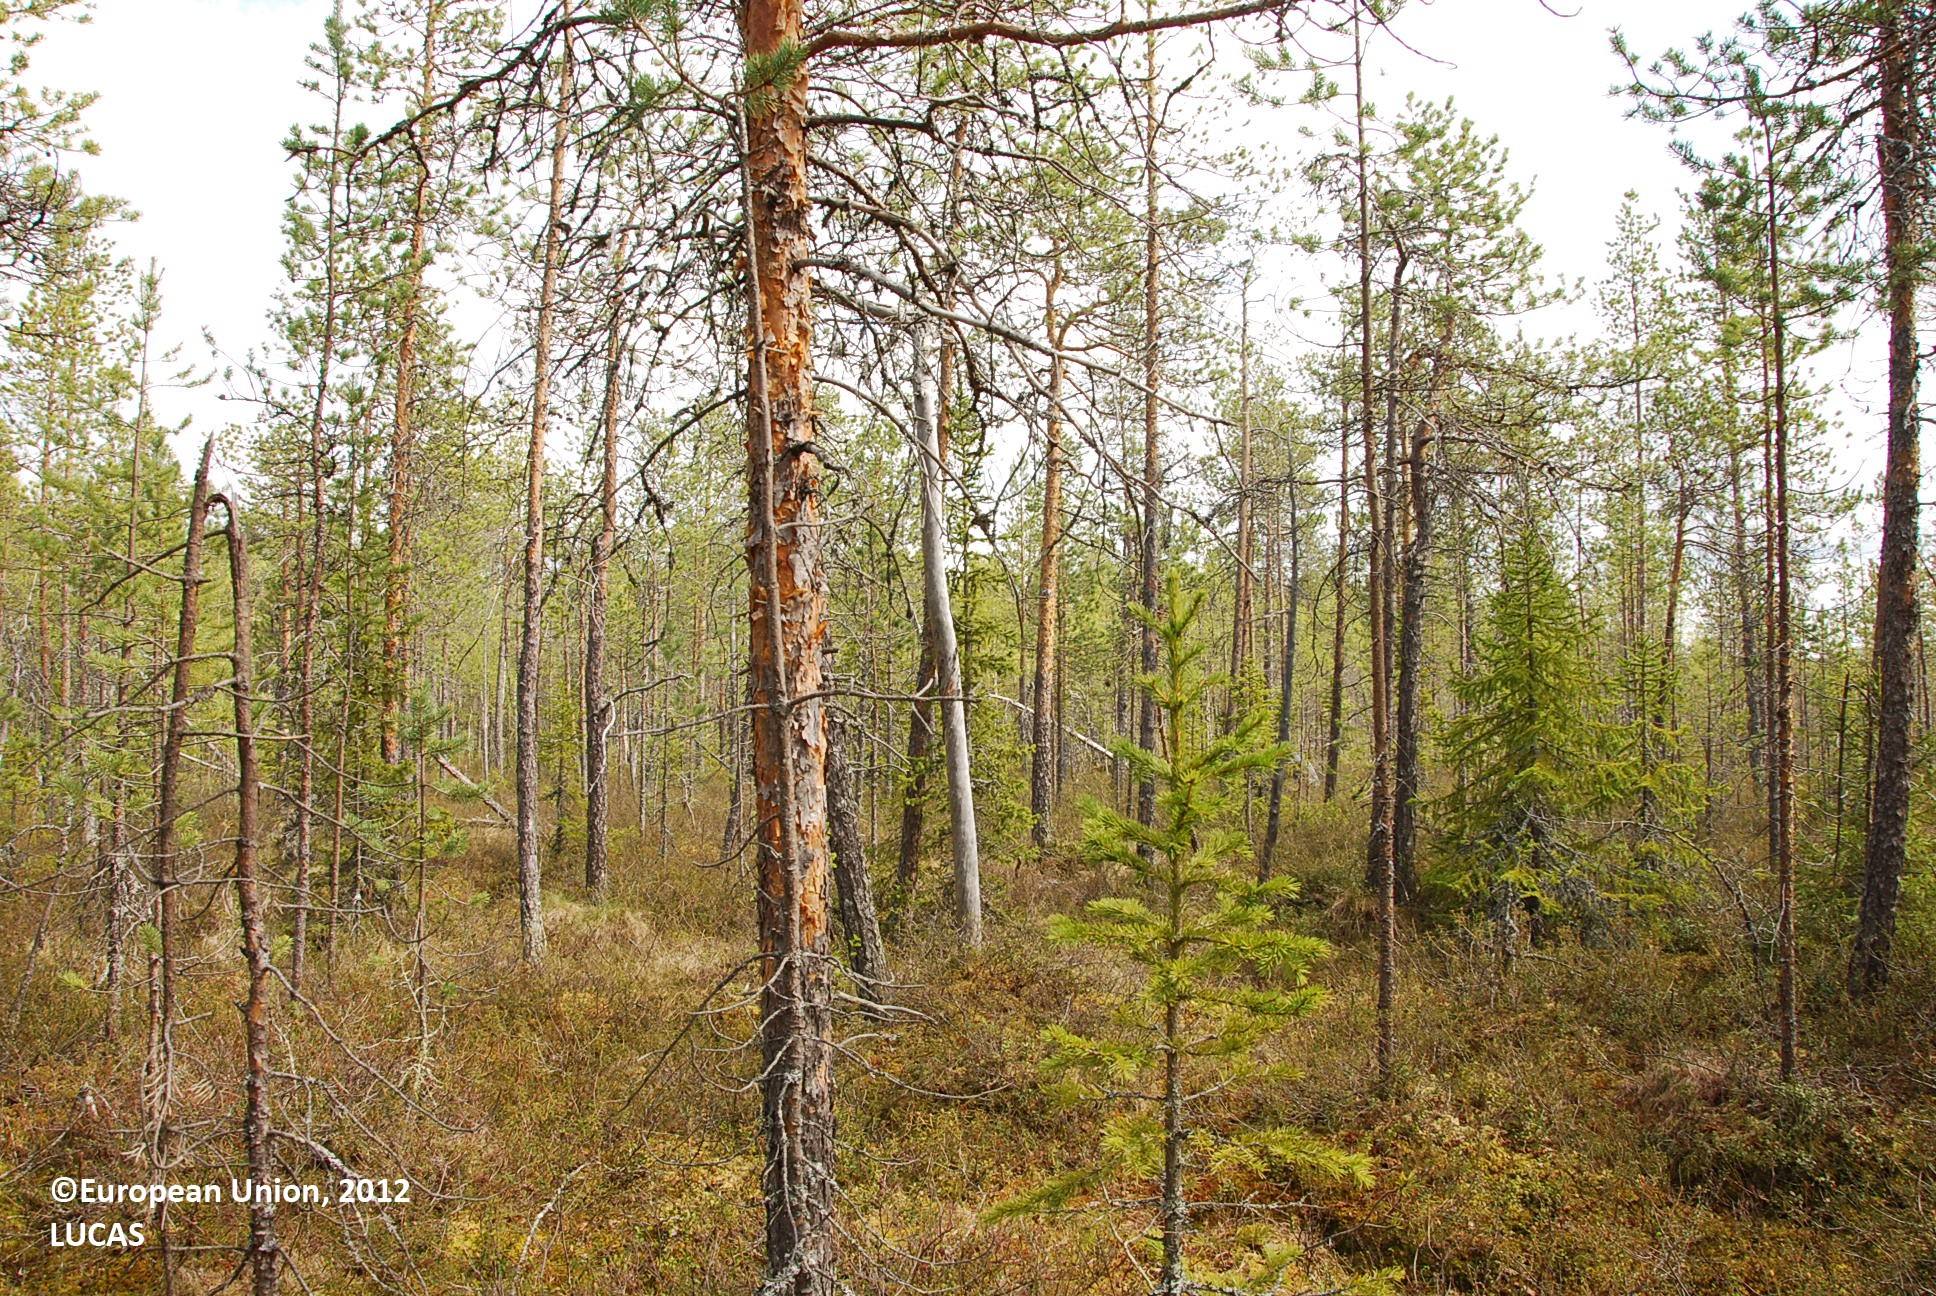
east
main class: Woodland
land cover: Pine dominated coniferous woodland
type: boreal forest
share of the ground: > 75 %
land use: Forestry
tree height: > 5 m
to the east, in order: Pine dominated coniferous woodland; Ditches and canals; Peatbogs; Pine dominated coniferous woodland; Ditches and canals; Spruce dominated coniferous woodland; Pine dominated coniferous woodland; Other mixed woodland; Pine dominated mixed woodland; Peatbogs; Ditches and canals; Peatbogs
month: June
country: FI
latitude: 66.5791
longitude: 28.0536
